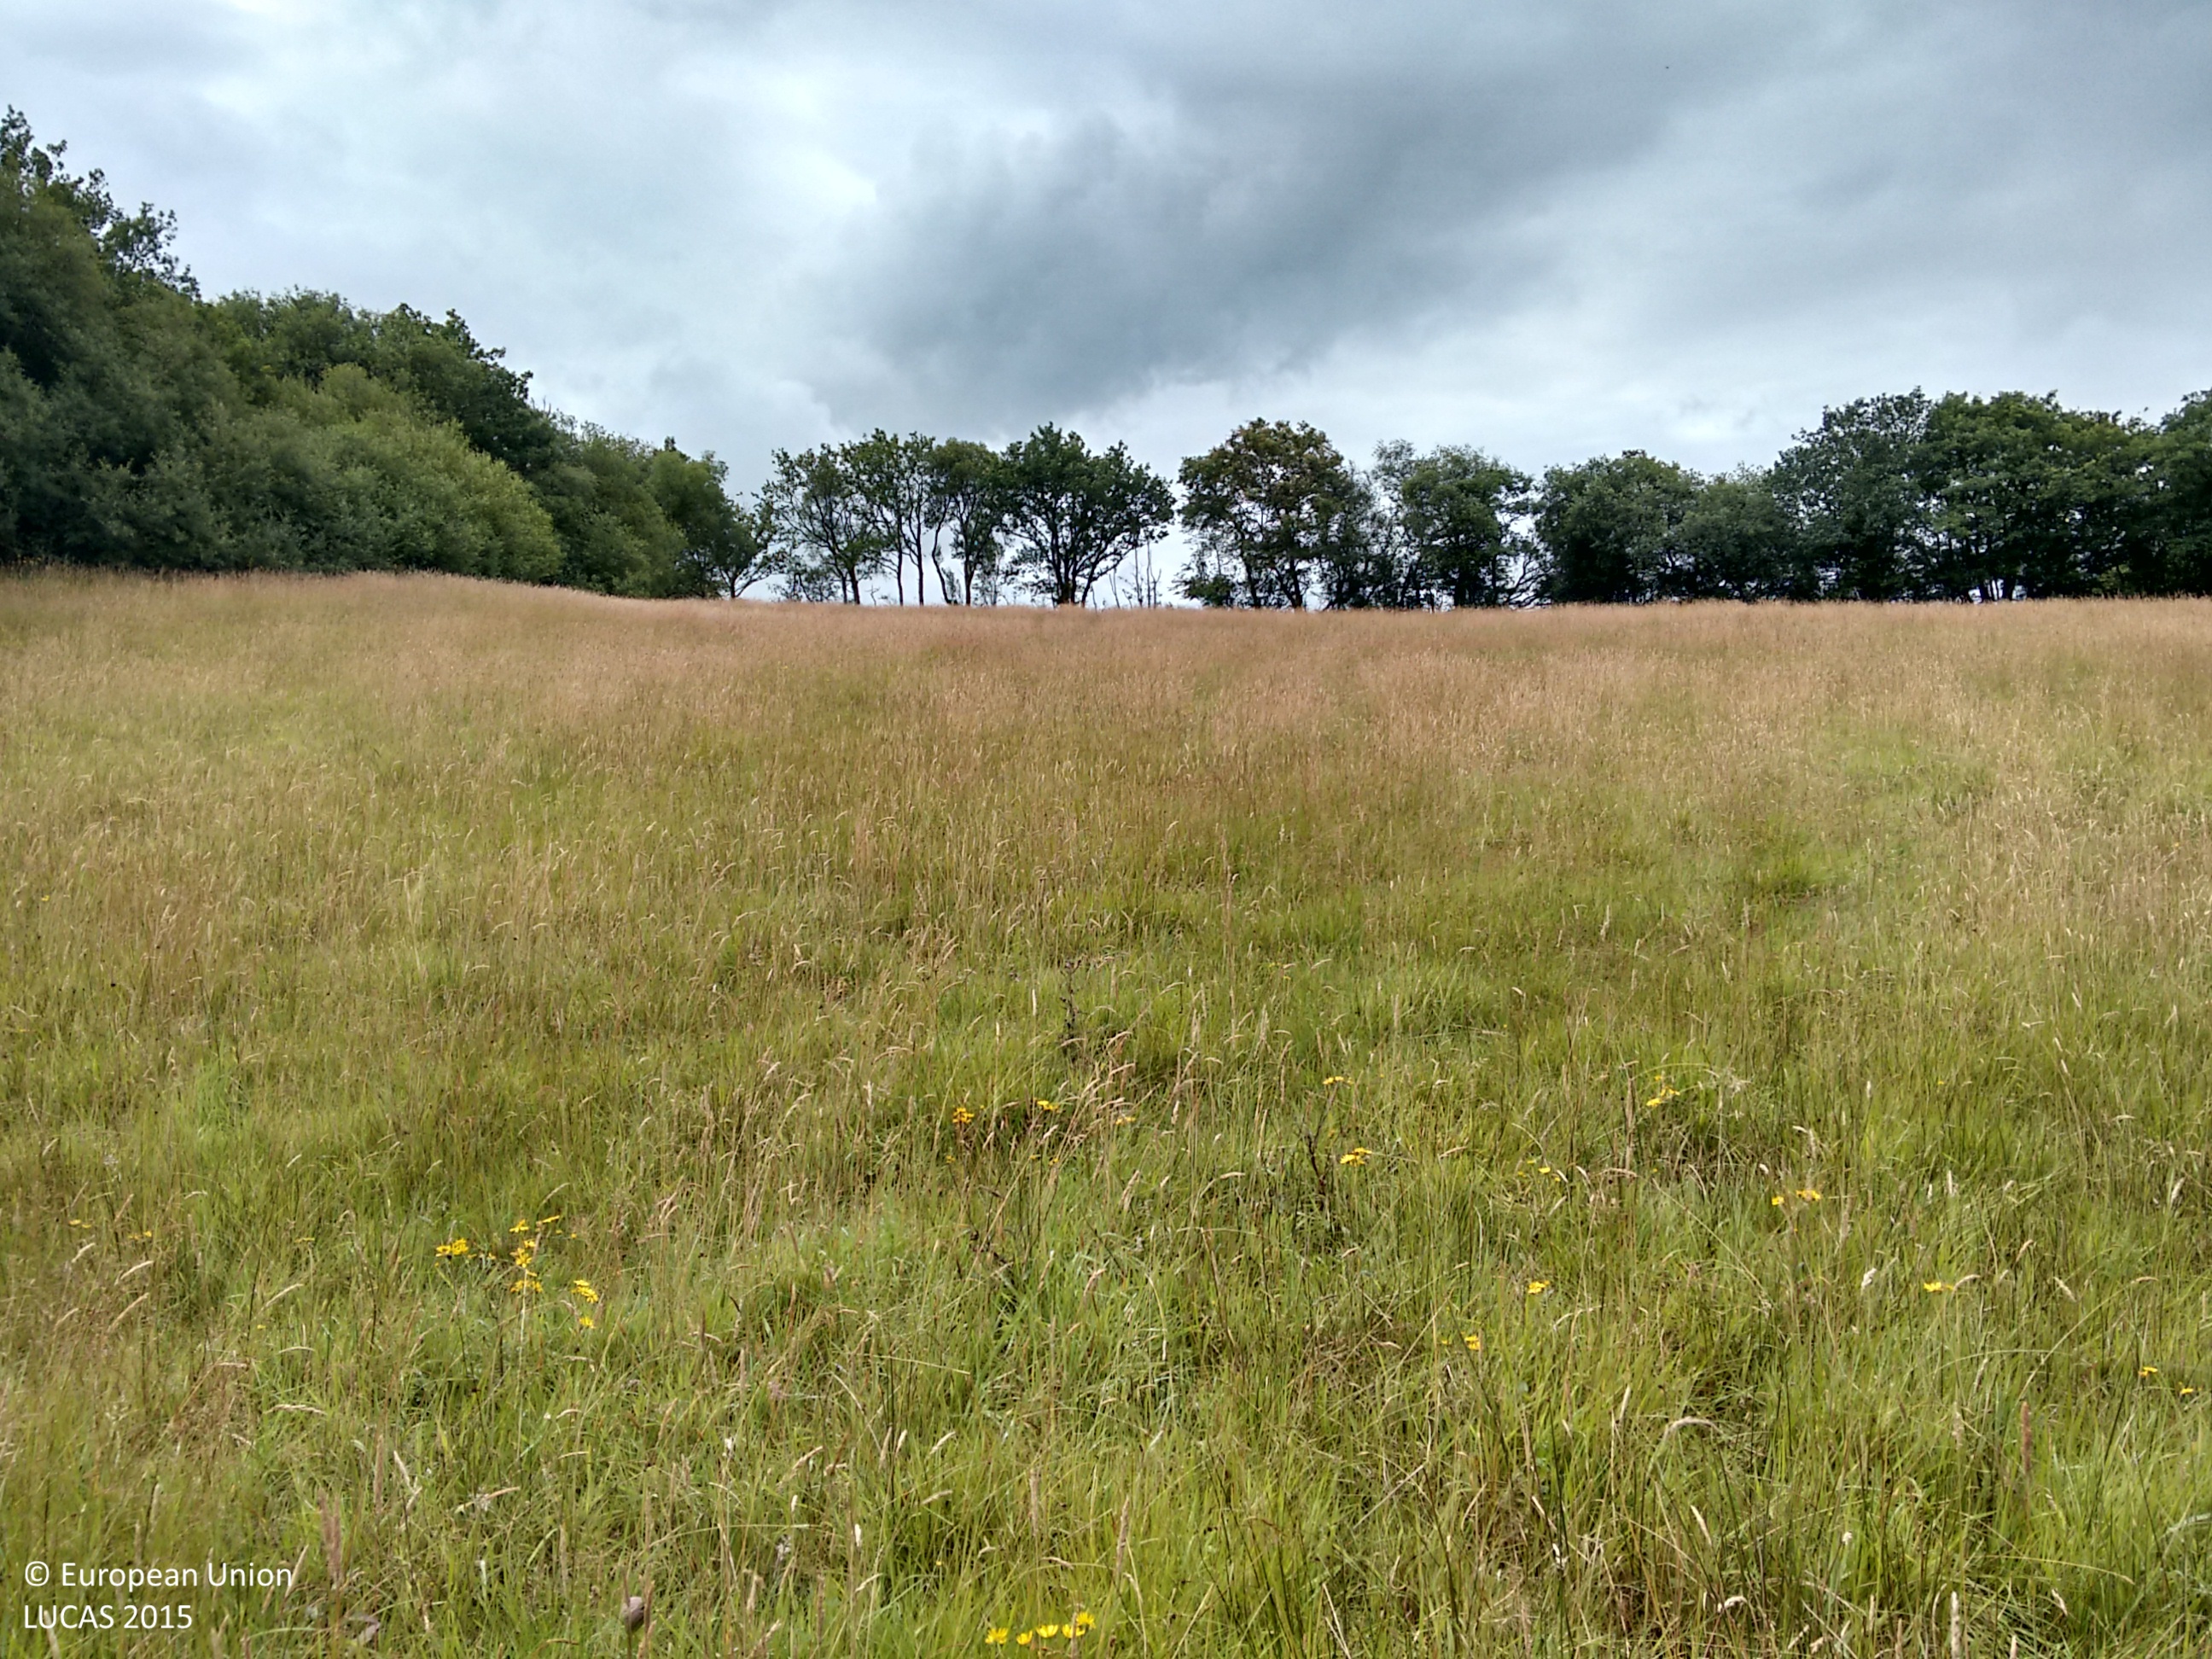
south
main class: Grassland
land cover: Grassland without tree/shrub cover
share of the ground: > 75 %
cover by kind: herbaceous plants 100 %
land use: Agriculture (excluding fallow land and kitchen gardens)
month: July
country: GB
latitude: 51.7734
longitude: -4.0521
